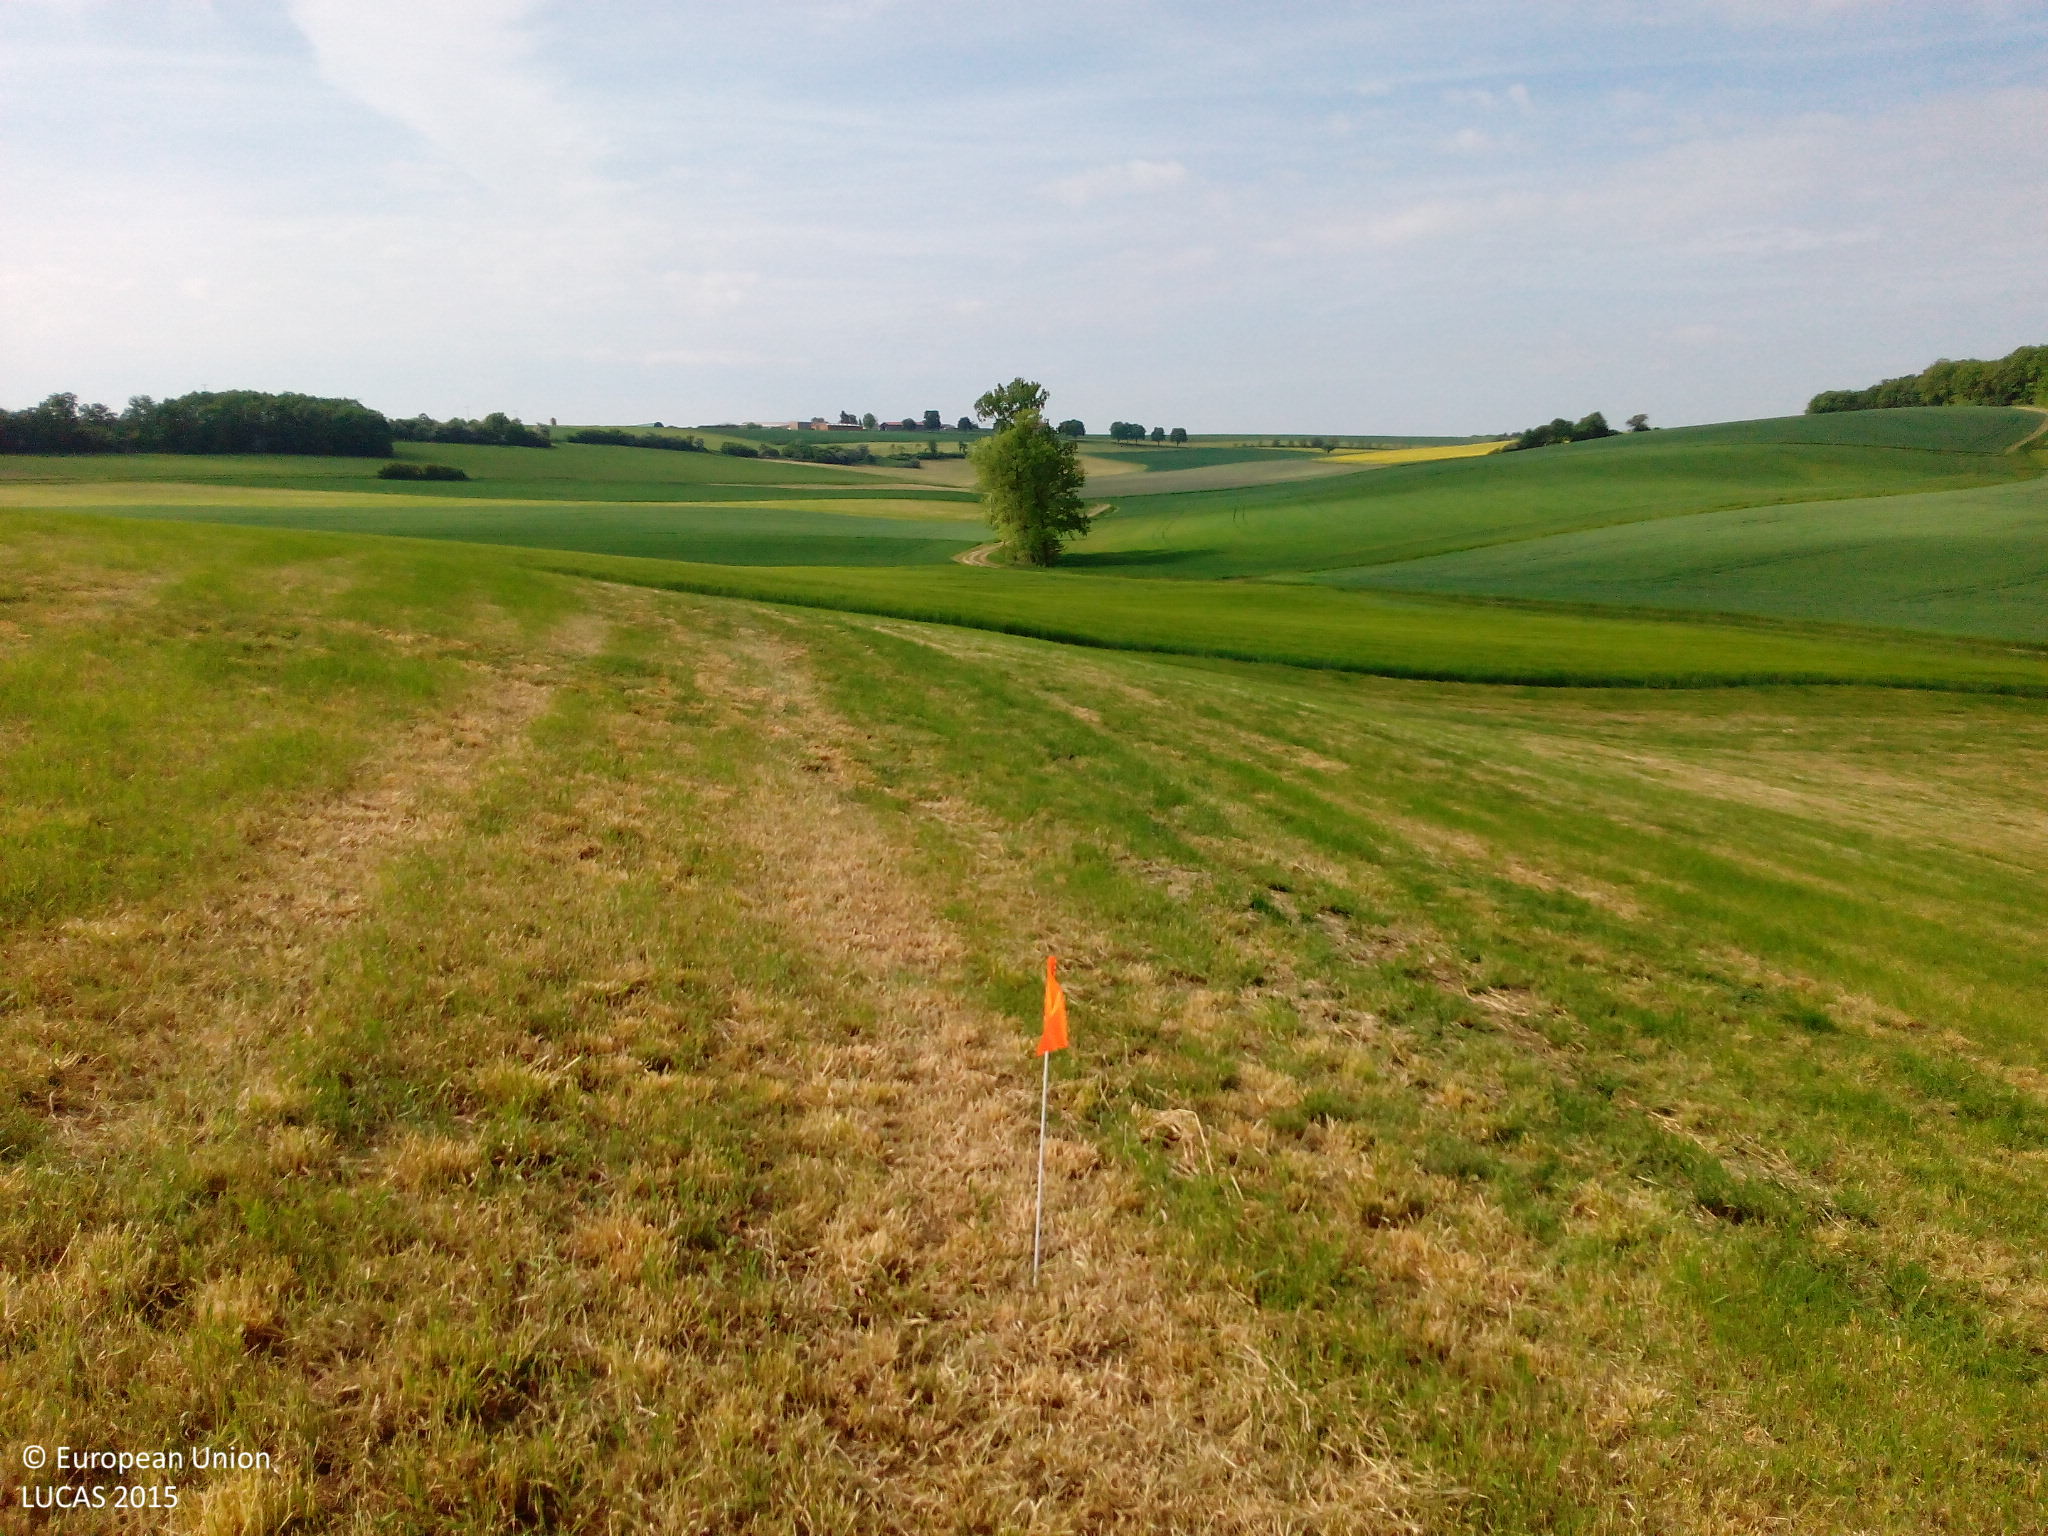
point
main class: Grassland
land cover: Grassland without tree/shrub cover
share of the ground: > 75 %
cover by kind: herbaceous plants 100 %
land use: Agriculture (excluding fallow land and kitchen gardens)
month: May
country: DE
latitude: 50.1444
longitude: 10.9373
